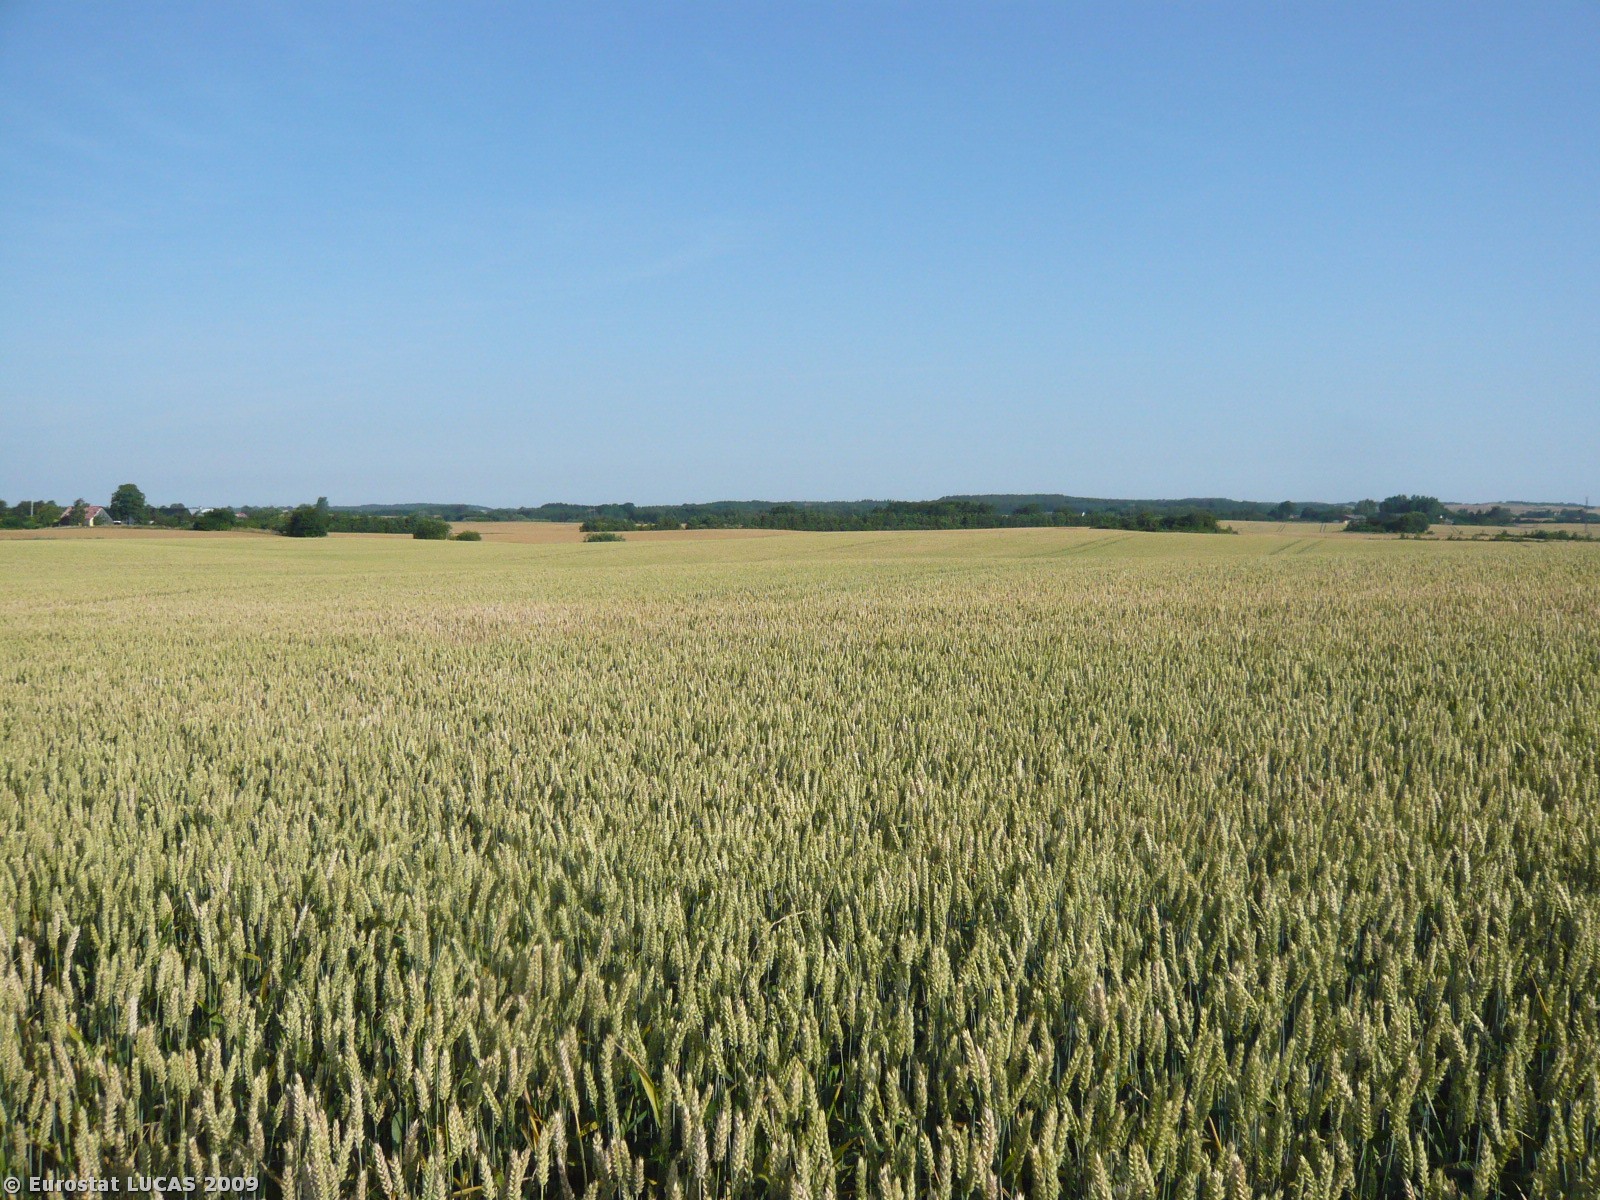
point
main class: Cropland
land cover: Common wheat
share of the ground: > 75 %
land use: Agriculture (excluding fallow land and kitchen gardens)
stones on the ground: < 10 %
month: July
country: DK
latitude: 55.5832
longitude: 11.6960
